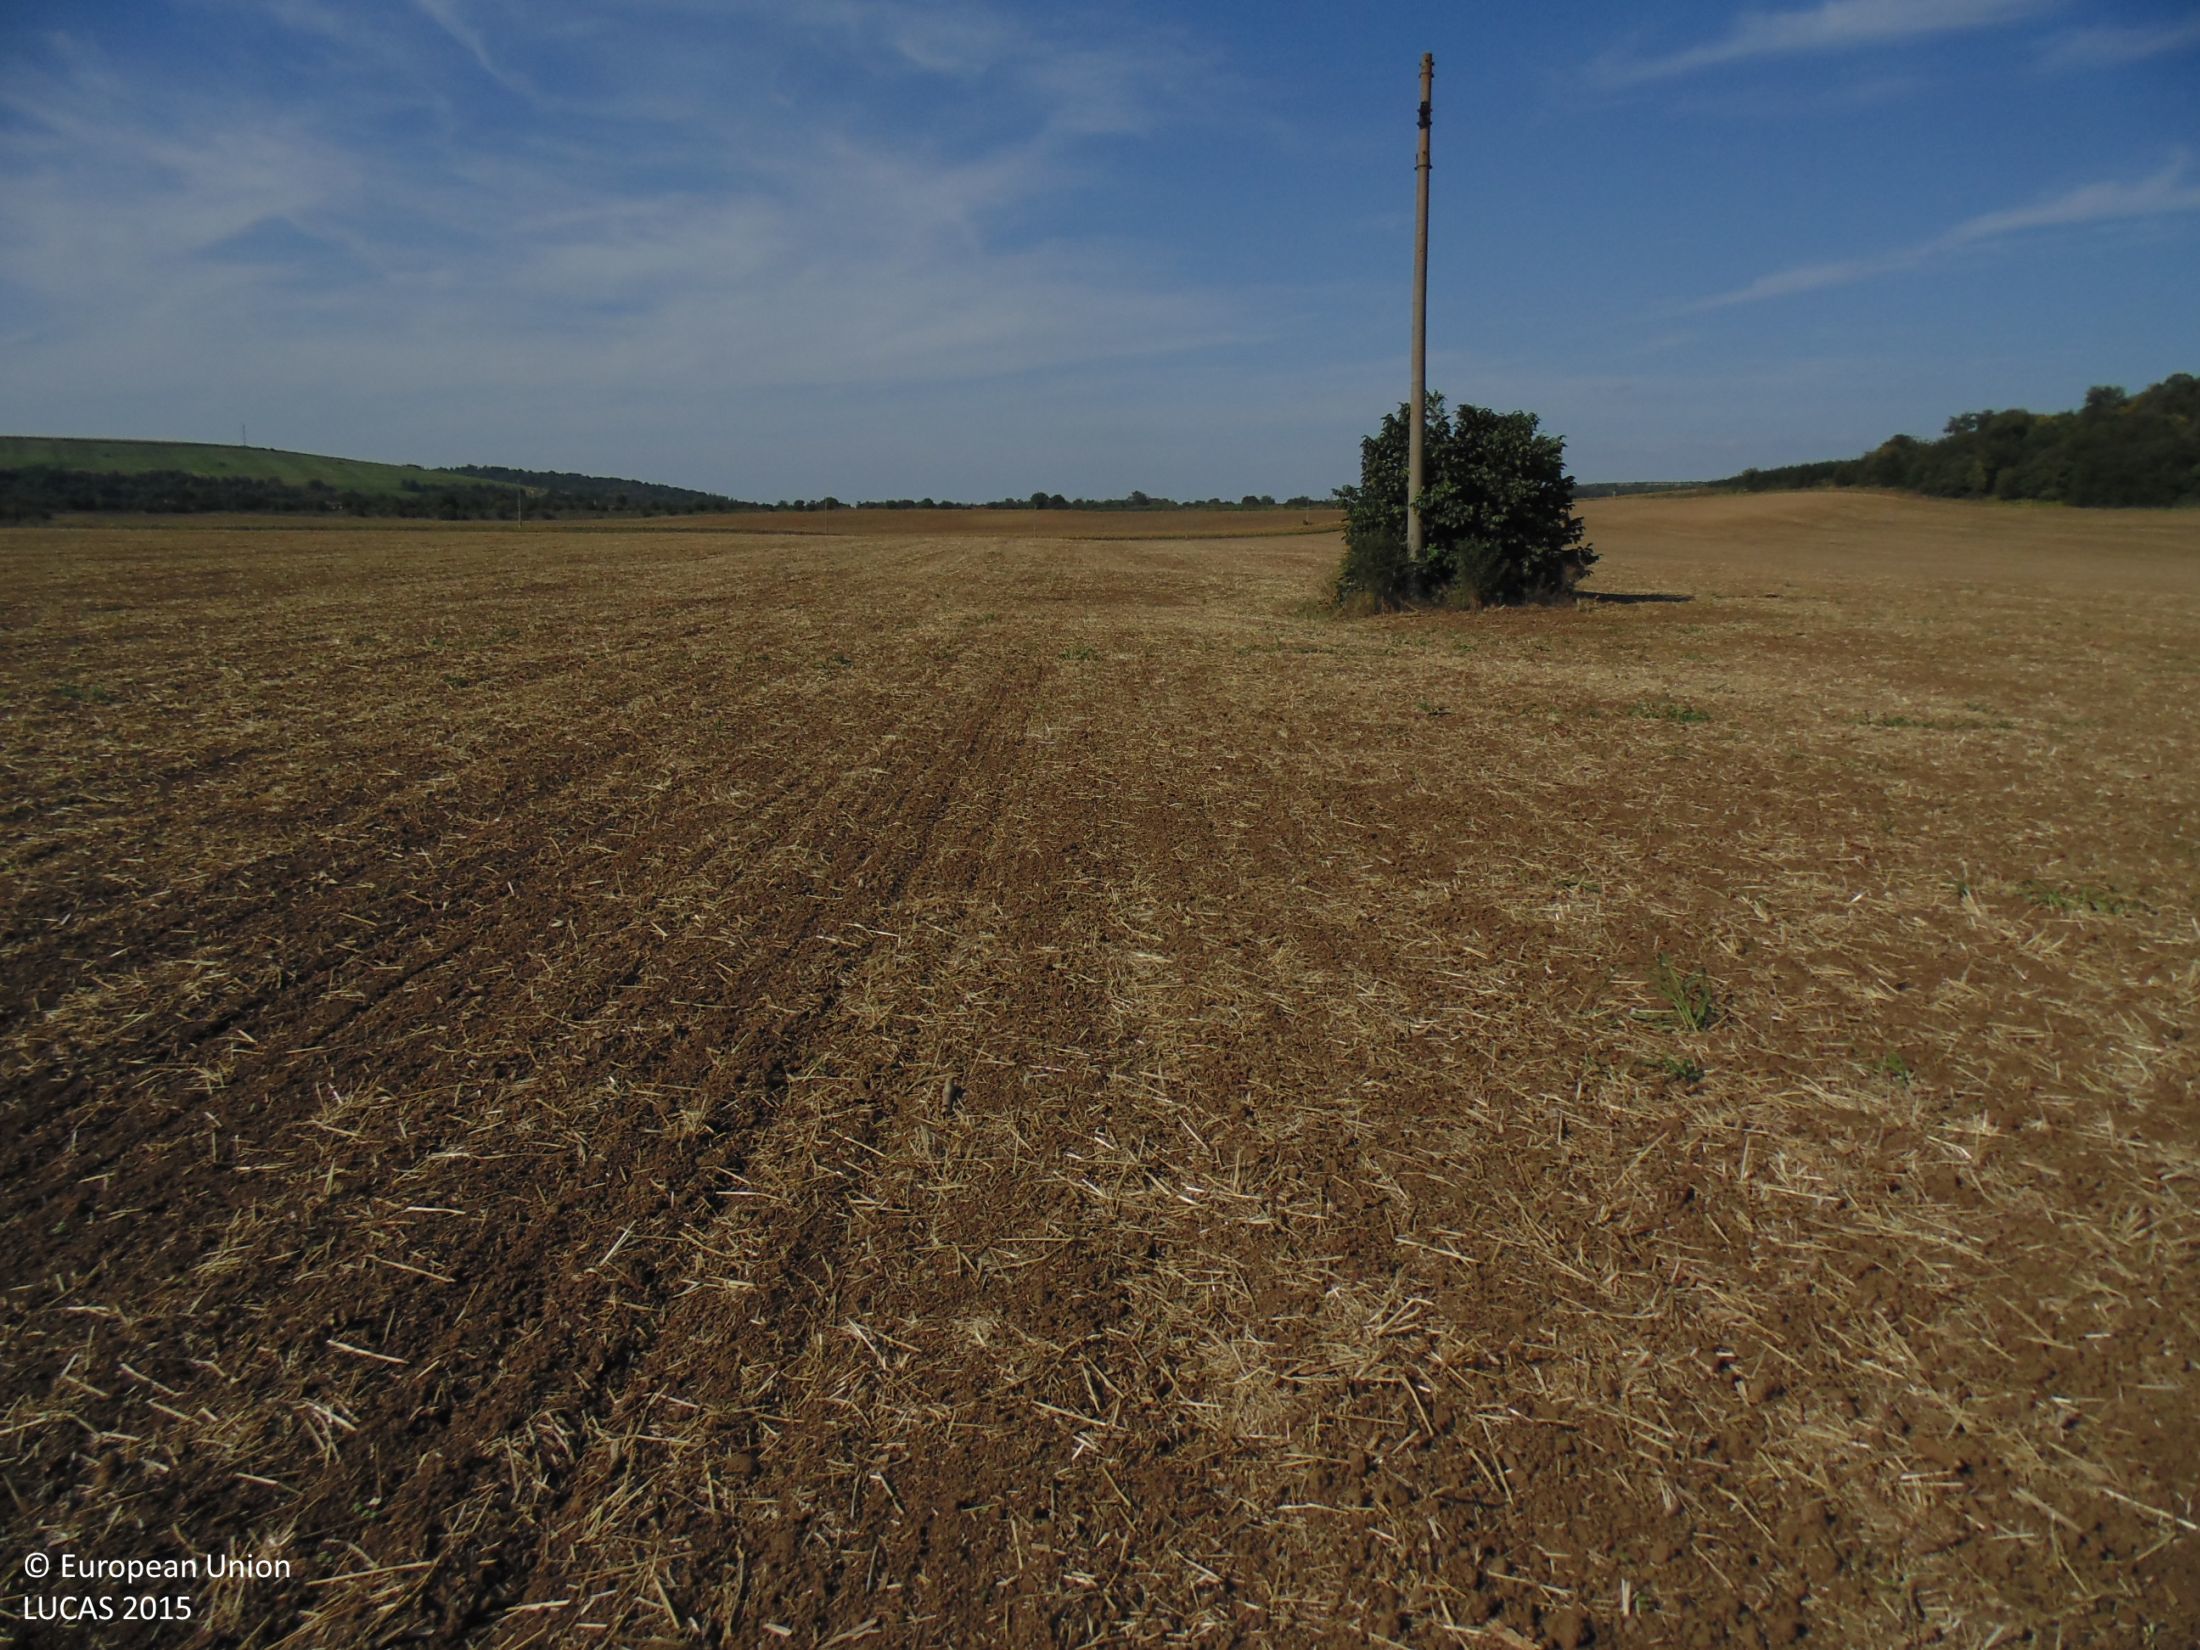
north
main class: Cropland
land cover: Common wheat
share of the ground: < 10 %
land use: Agriculture (excluding fallow land and kitchen gardens)
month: September
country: BG
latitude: 44.0718
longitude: 26.9154
